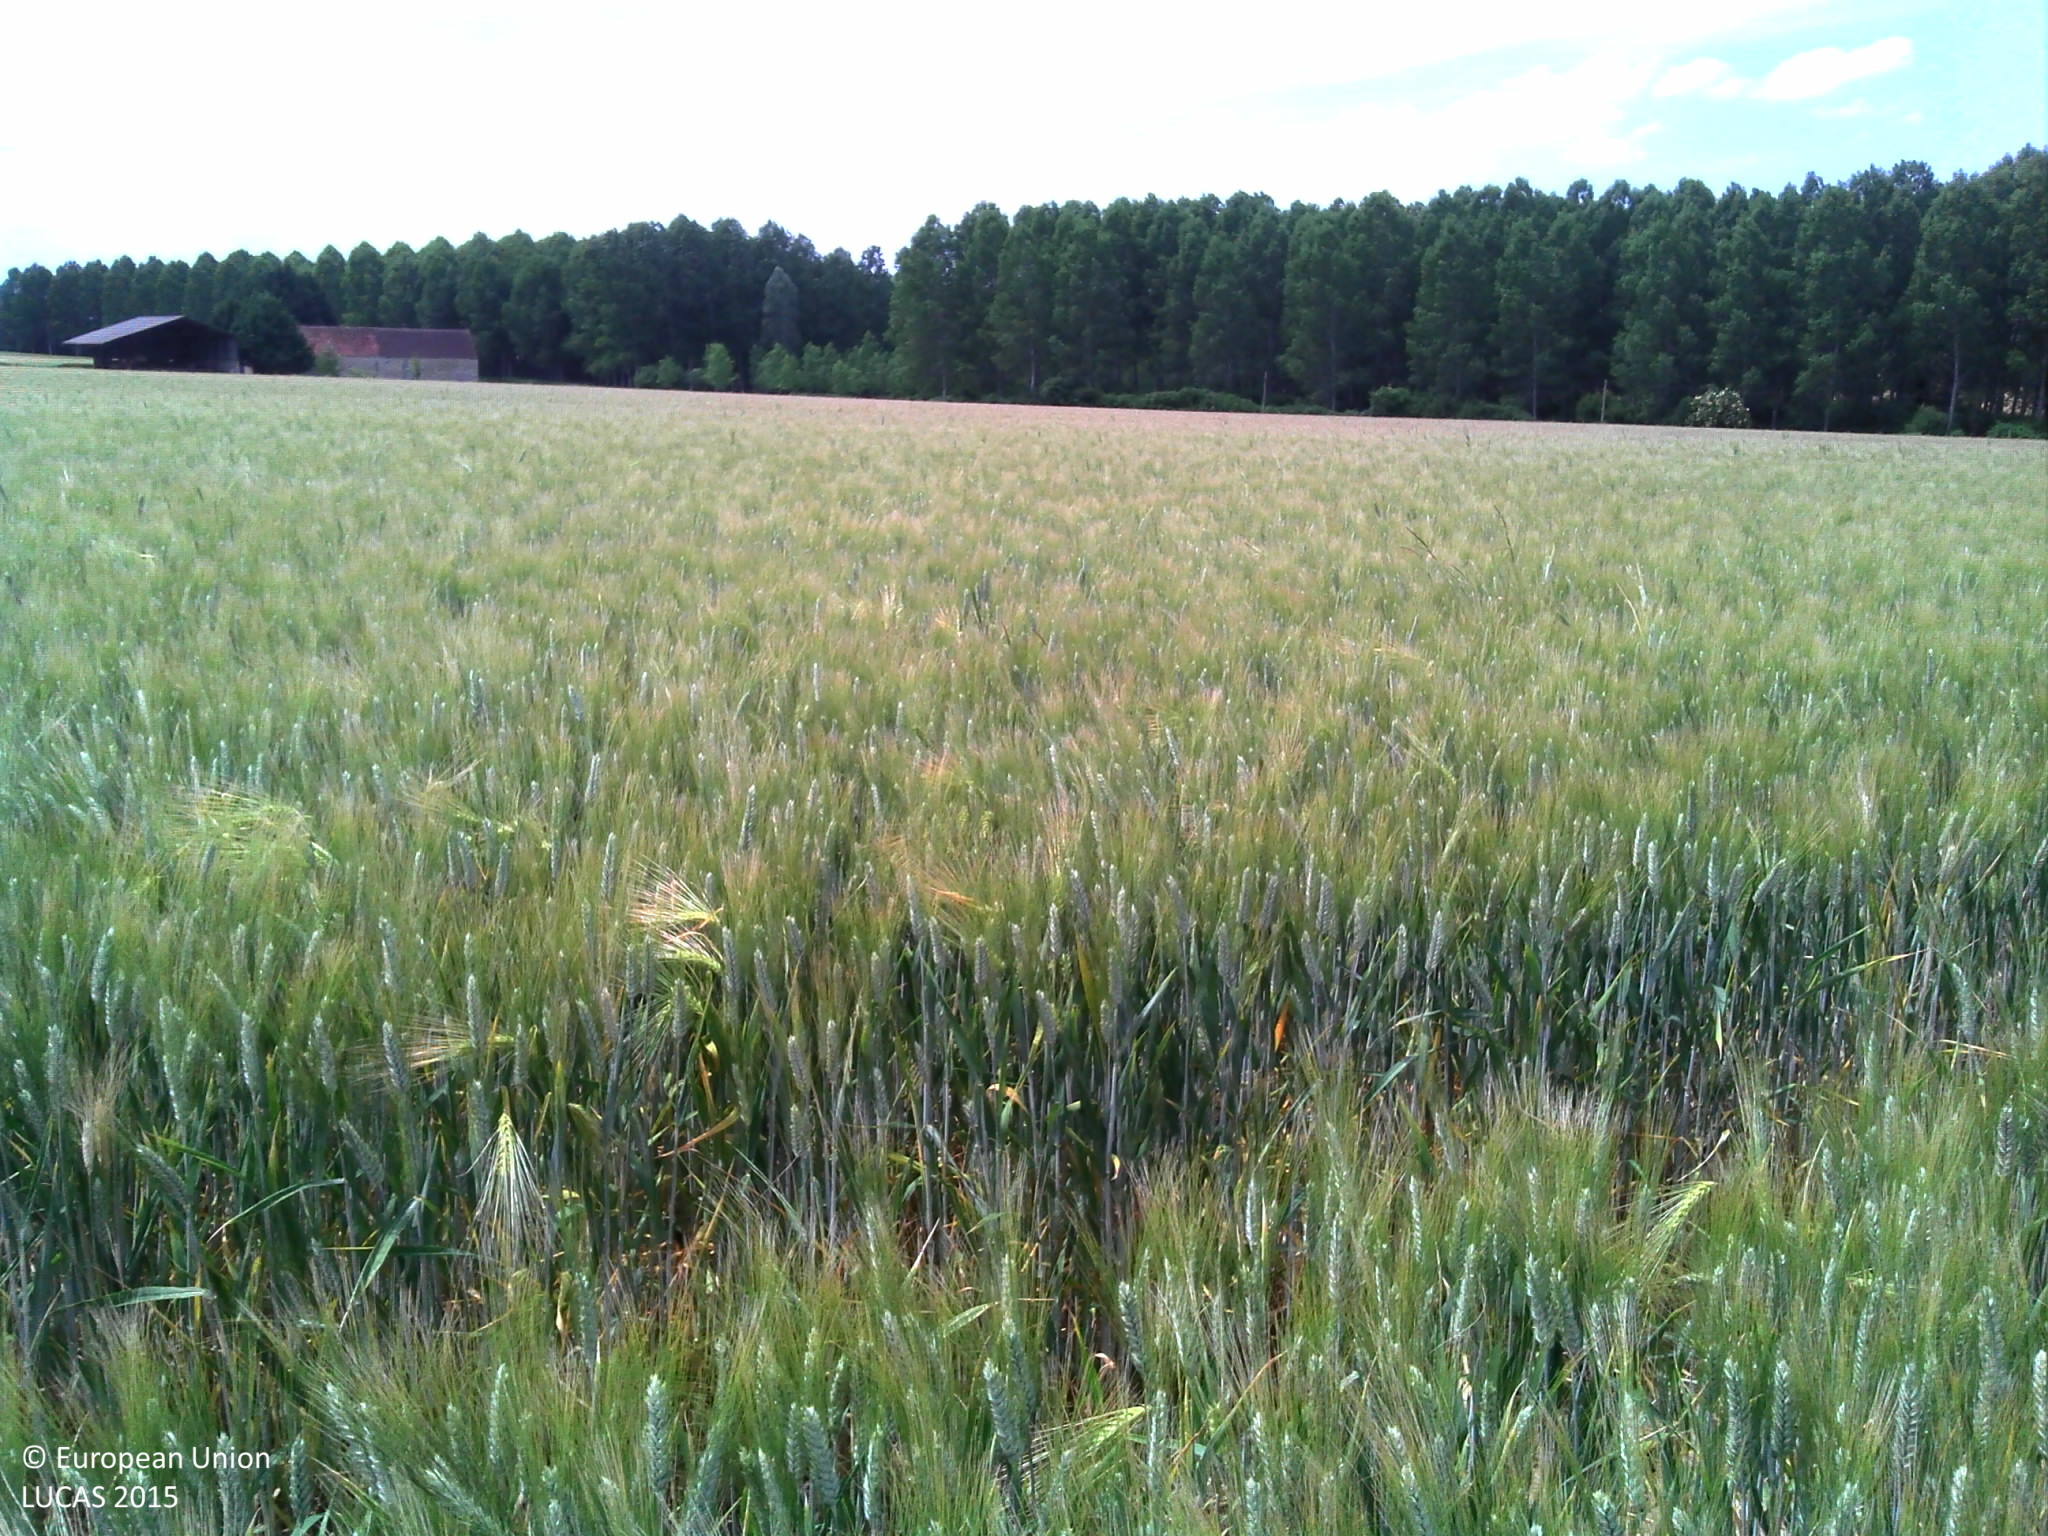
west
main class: Cropland
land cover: Common wheat
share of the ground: > 75 %
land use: Agriculture (excluding fallow land and kitchen gardens)
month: June
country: FR
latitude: 46.9300
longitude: 2.6525
